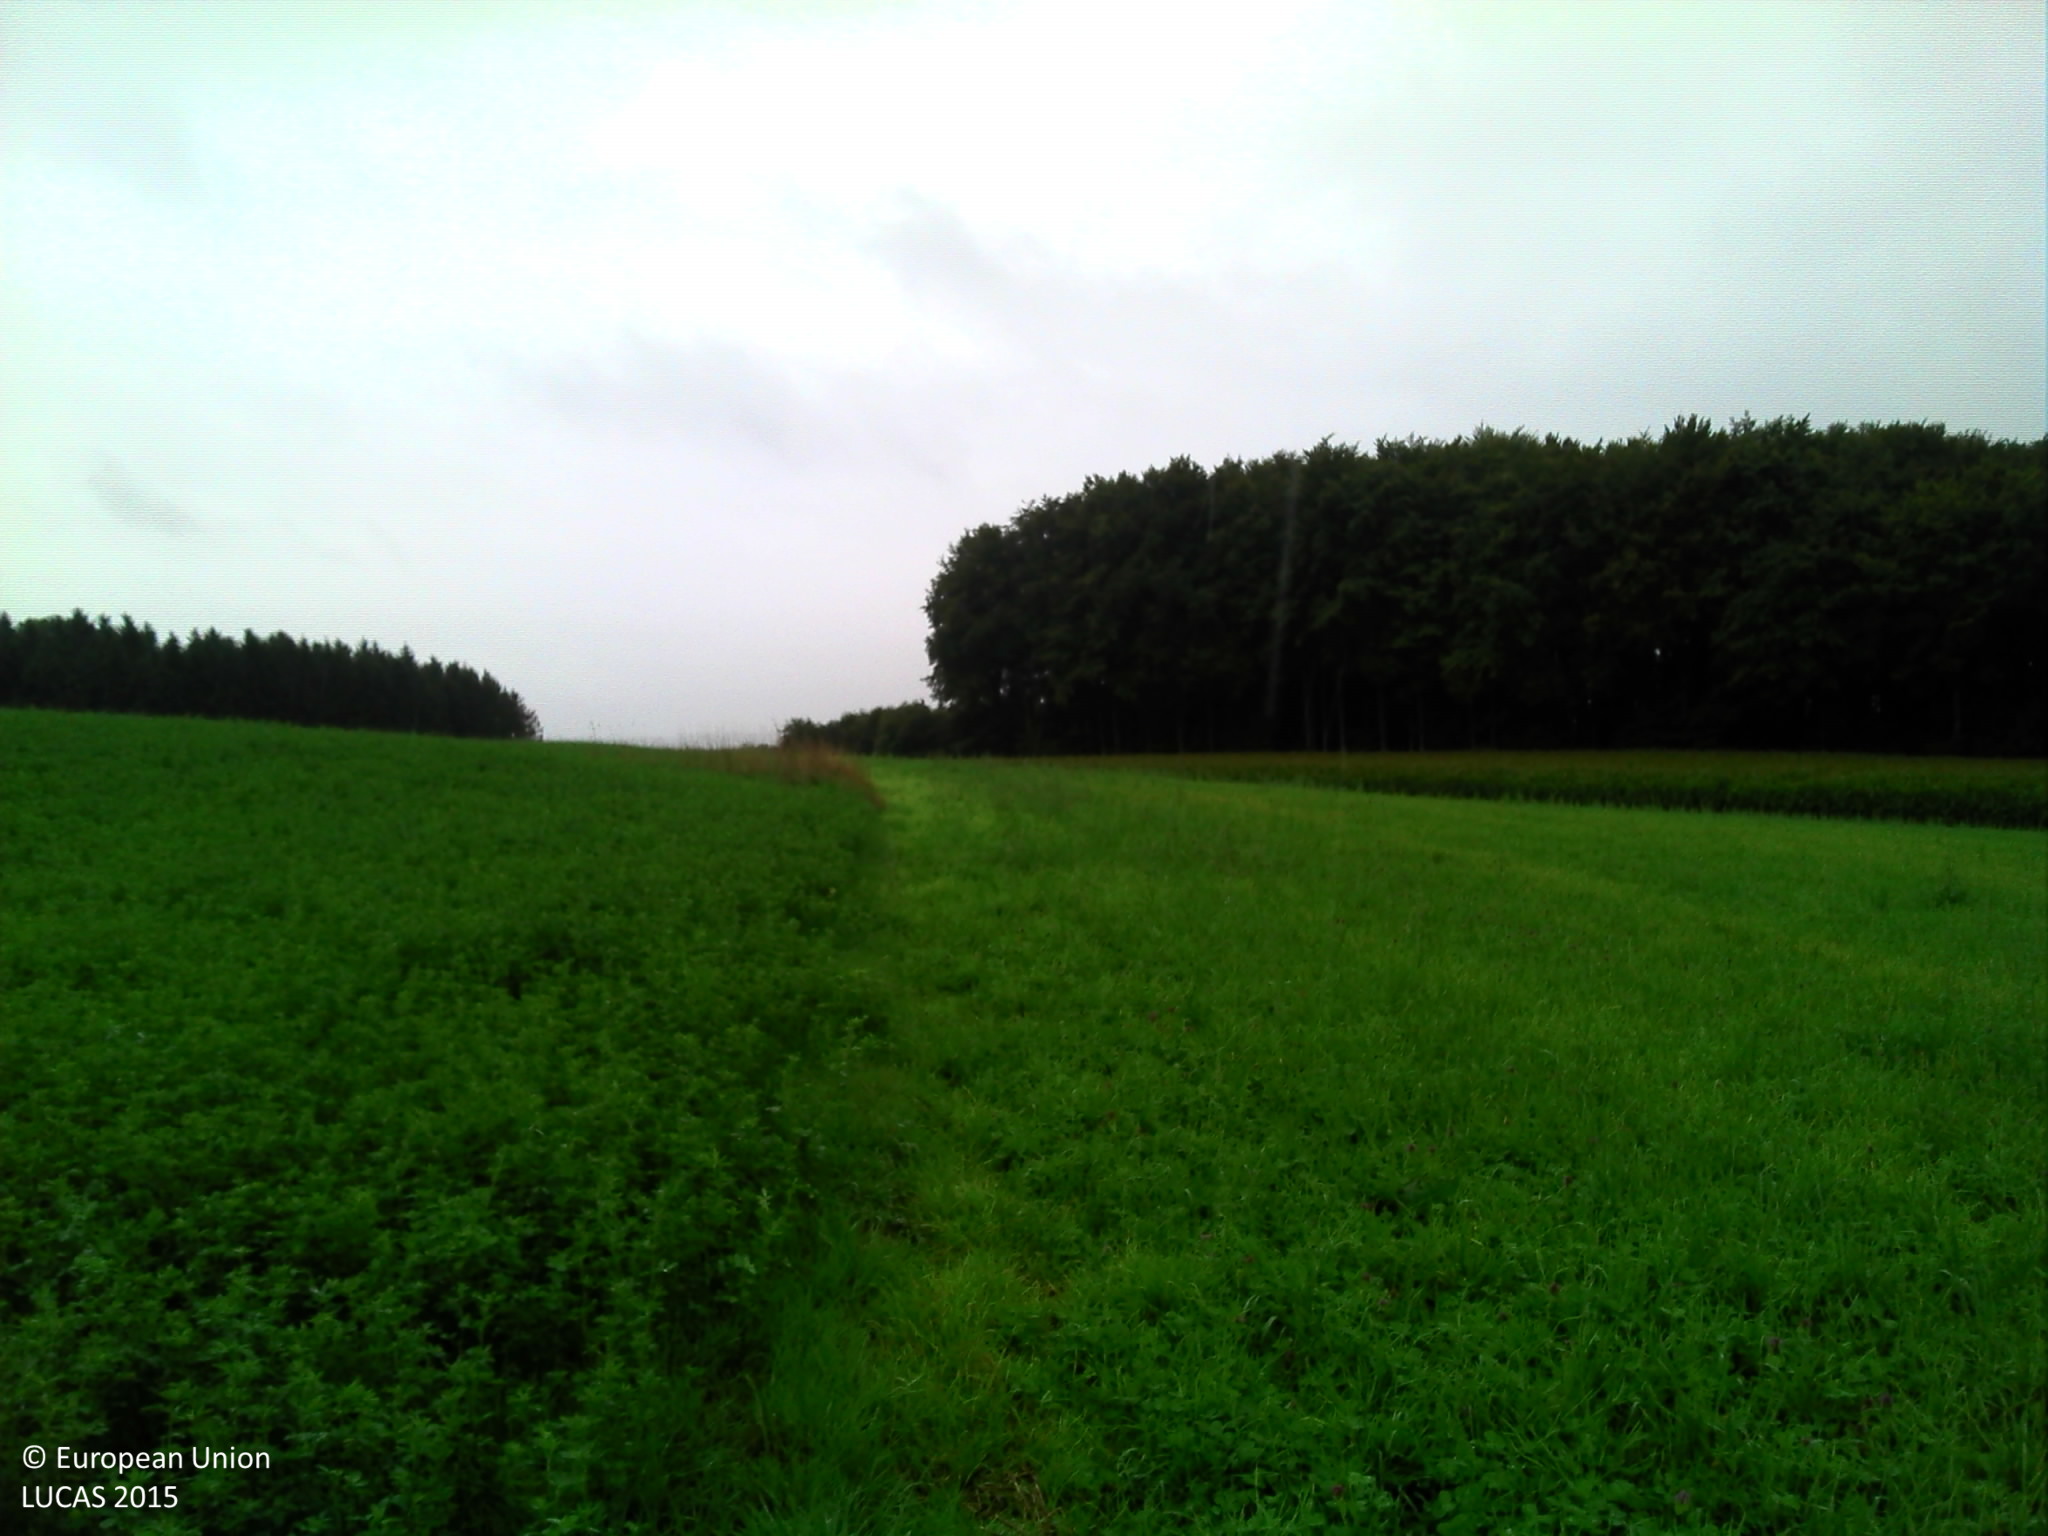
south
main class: Cropland
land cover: Lucerne
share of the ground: > 75 %
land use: Agriculture (excluding fallow land and kitchen gardens)
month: September
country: LU
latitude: 49.7855
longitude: 5.8739
